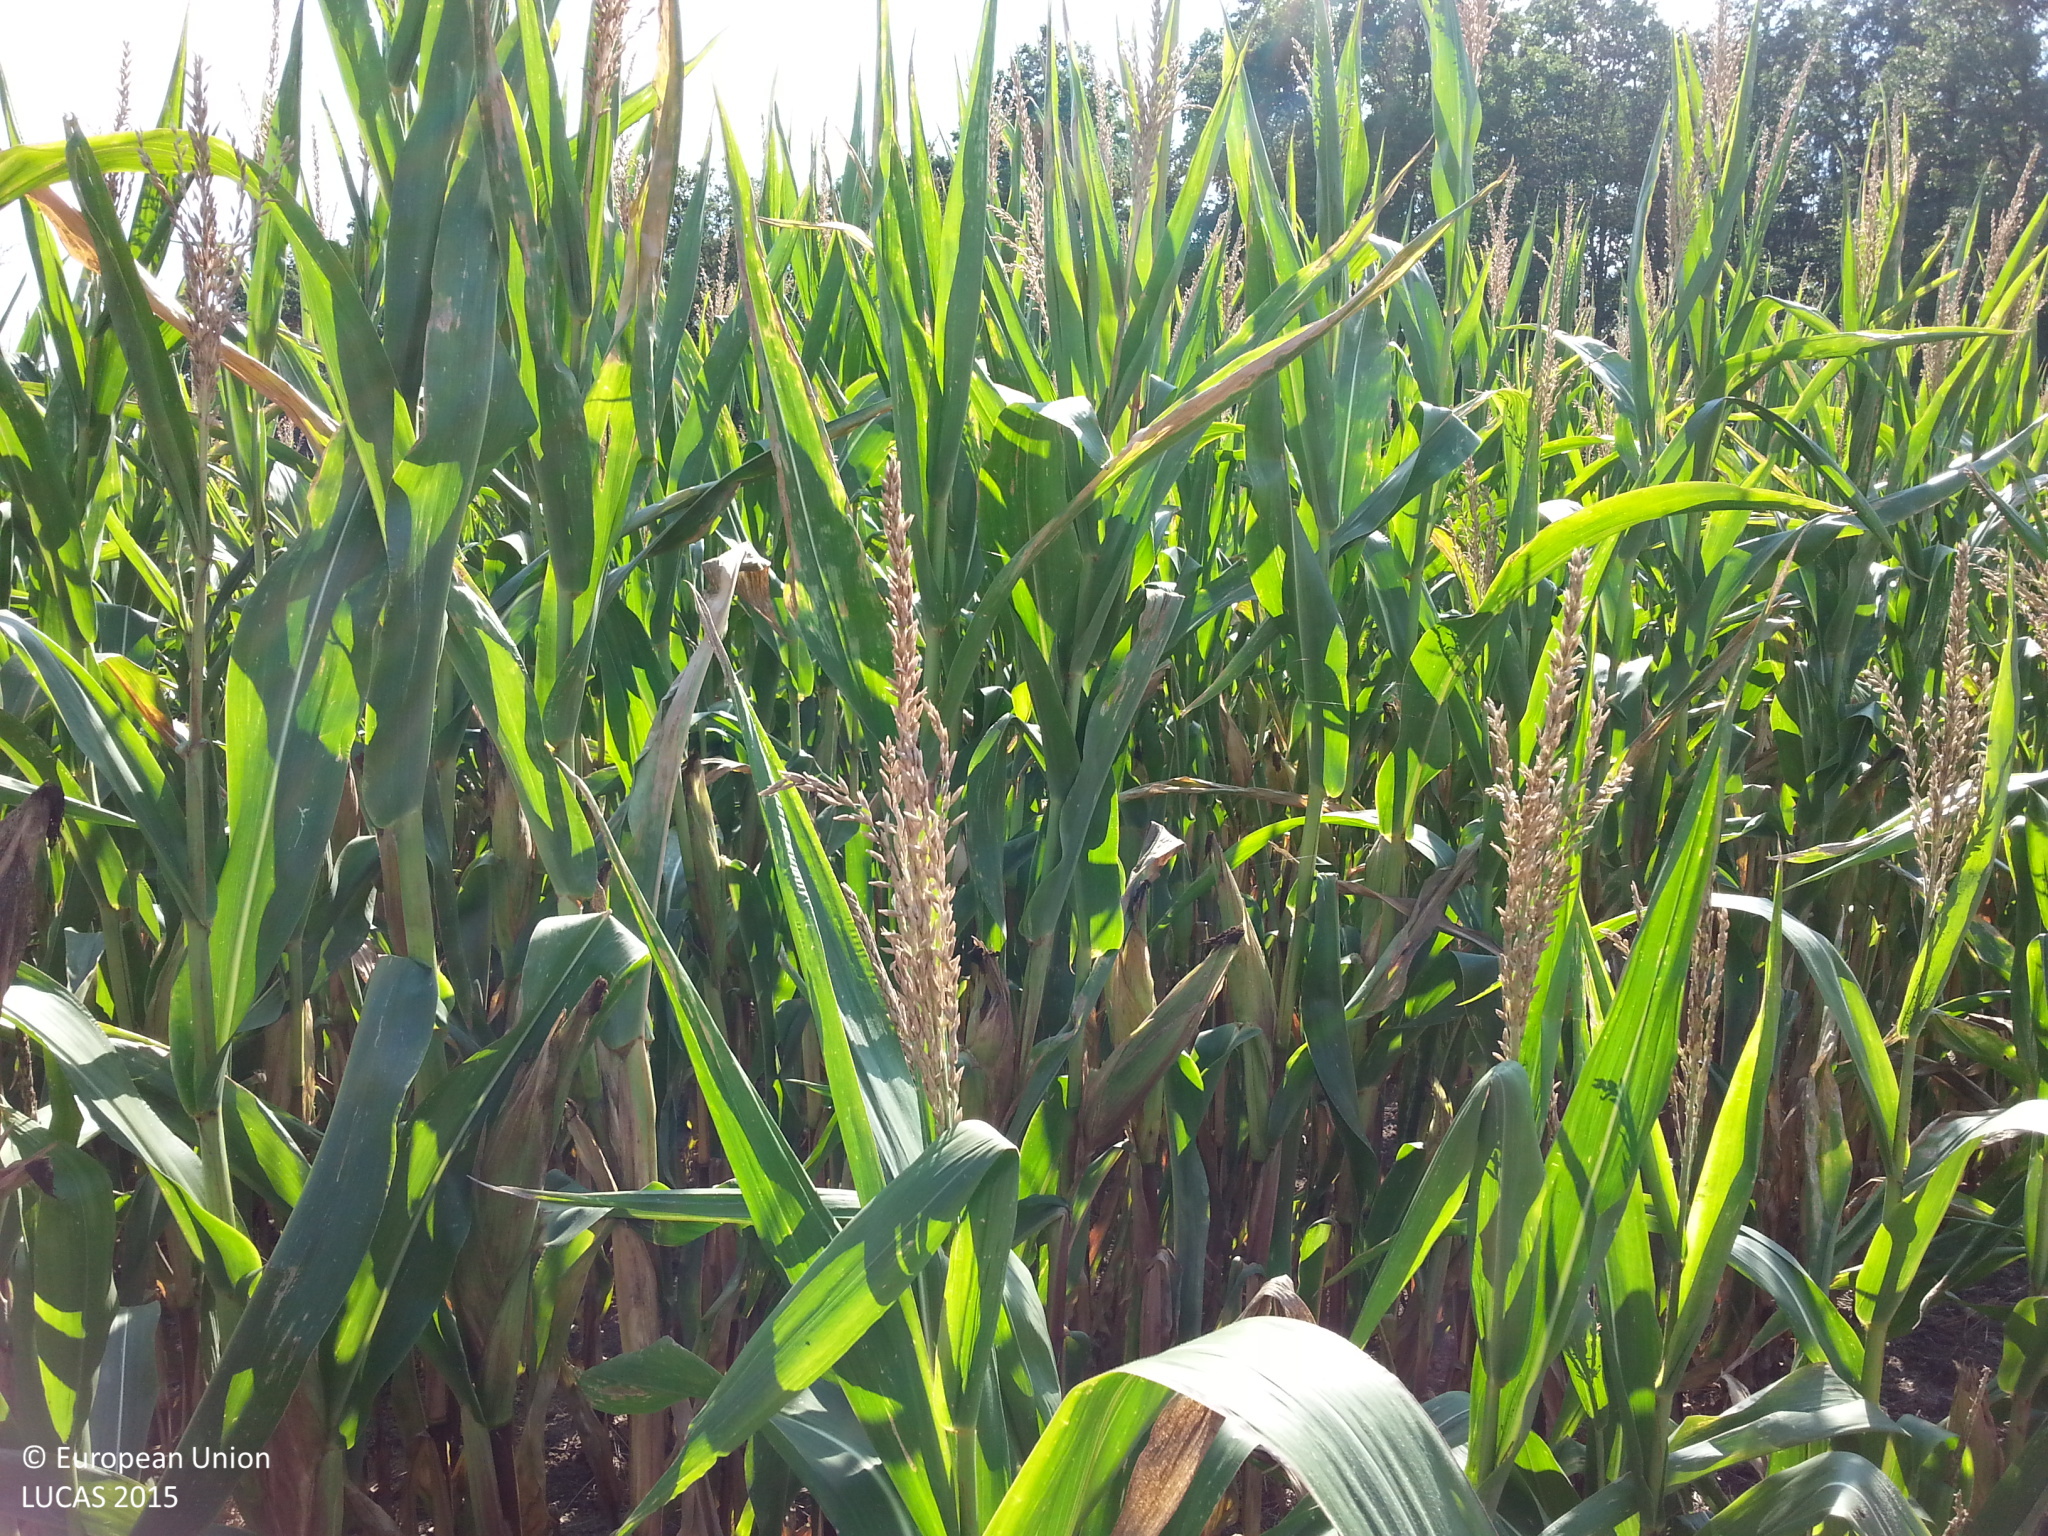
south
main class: Cropland
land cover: Maize
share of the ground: > 75 %
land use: Agriculture (excluding fallow land and kitchen gardens)
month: September
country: DE
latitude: 49.3569
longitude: 9.9037
